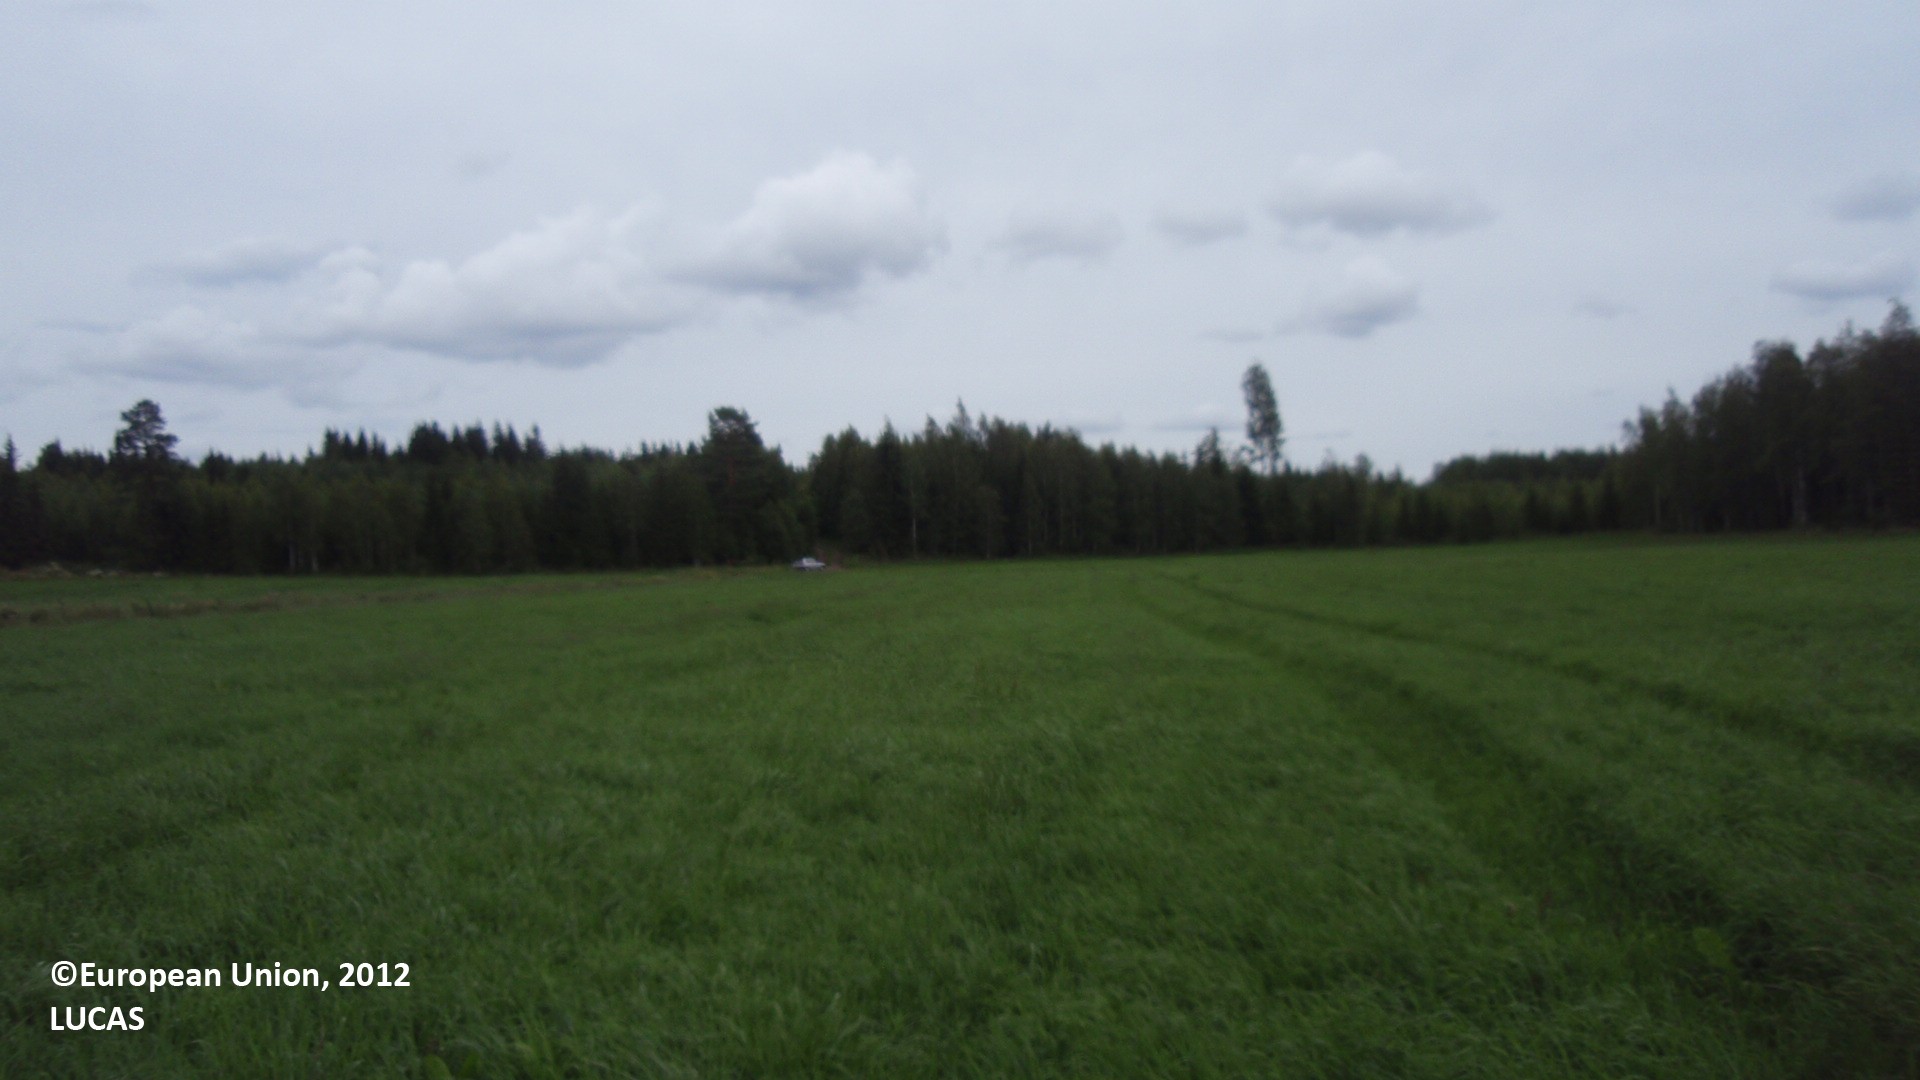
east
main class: Cropland
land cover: Temporary grasslands
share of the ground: > 75 %
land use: Agriculture (excluding fallow land and kitchen gardens)
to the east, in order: Temporary grasslands; Grass margins; Ditches and canals; Pine dominated mixed woodland
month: July
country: FI
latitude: 61.3593
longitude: 28.7569
